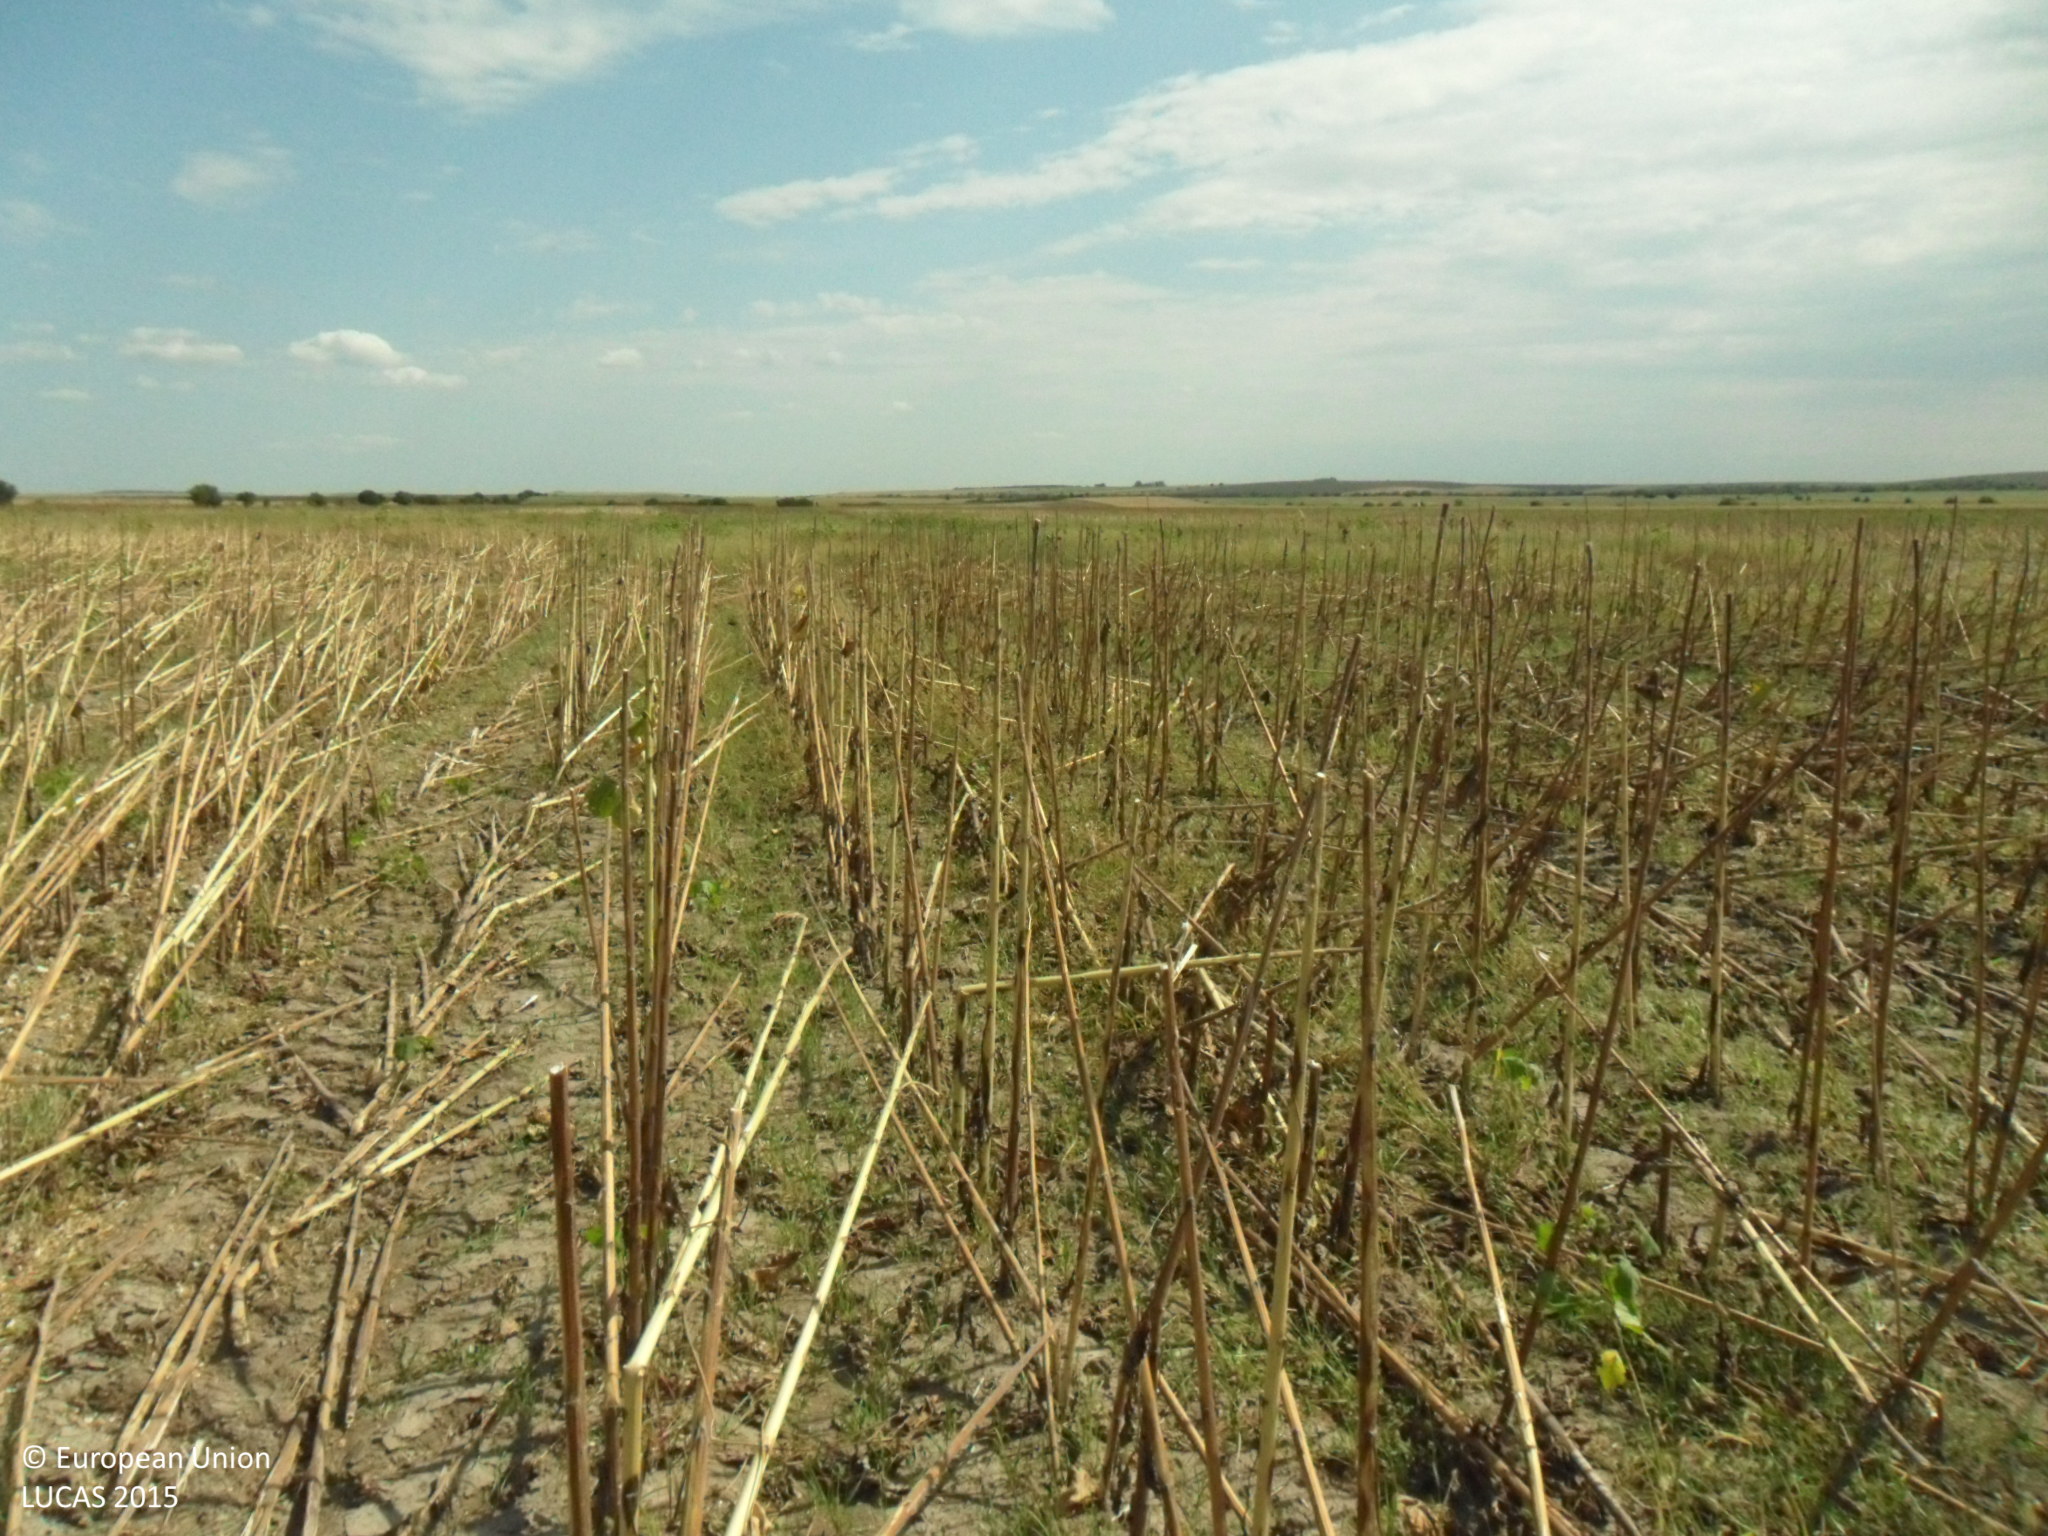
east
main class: Cropland
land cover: Sunflower
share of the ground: < 10 %
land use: Agriculture (excluding fallow land and kitchen gardens)
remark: Harvested field
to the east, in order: Sunflower
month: September
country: BG
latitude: 43.9371
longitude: 26.3891
